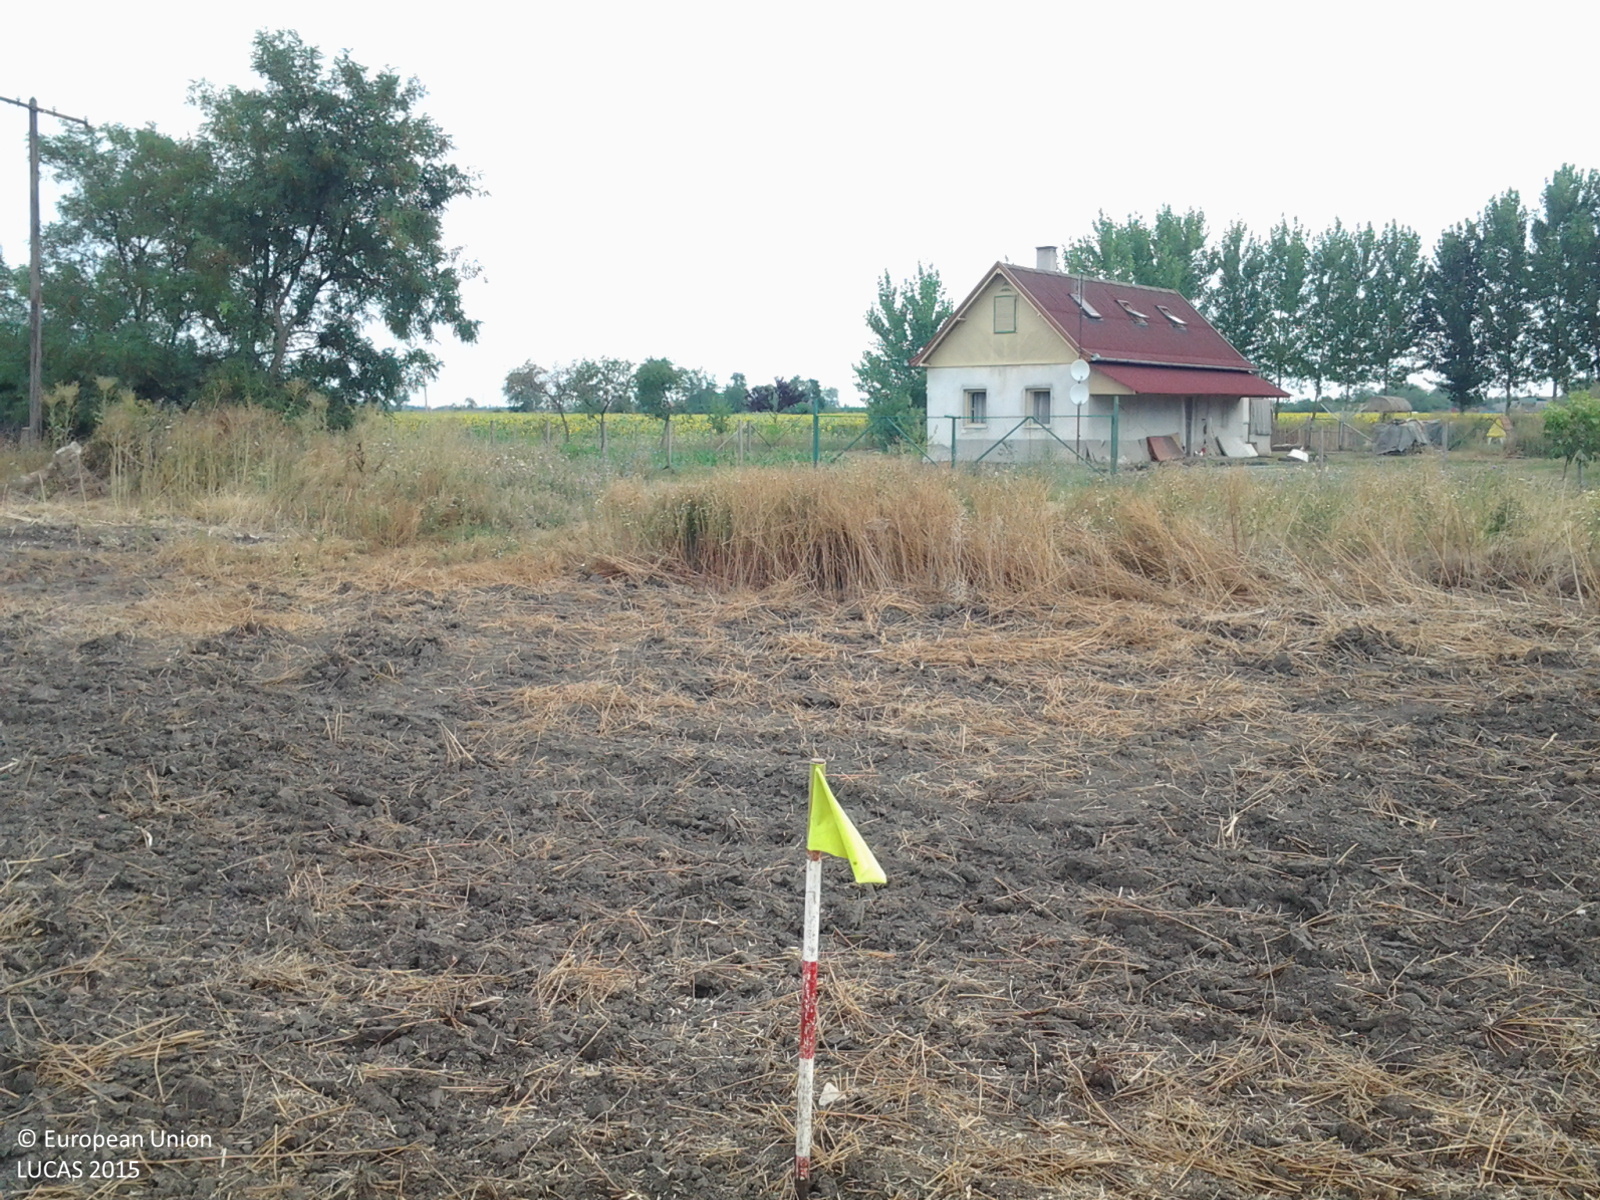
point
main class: Cropland
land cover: Rape and turnip rape
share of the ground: < 10 %
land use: Agriculture (excluding fallow land and kitchen gardens)
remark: Harvested field
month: July
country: HU
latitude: 47.1770
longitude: 20.4929
